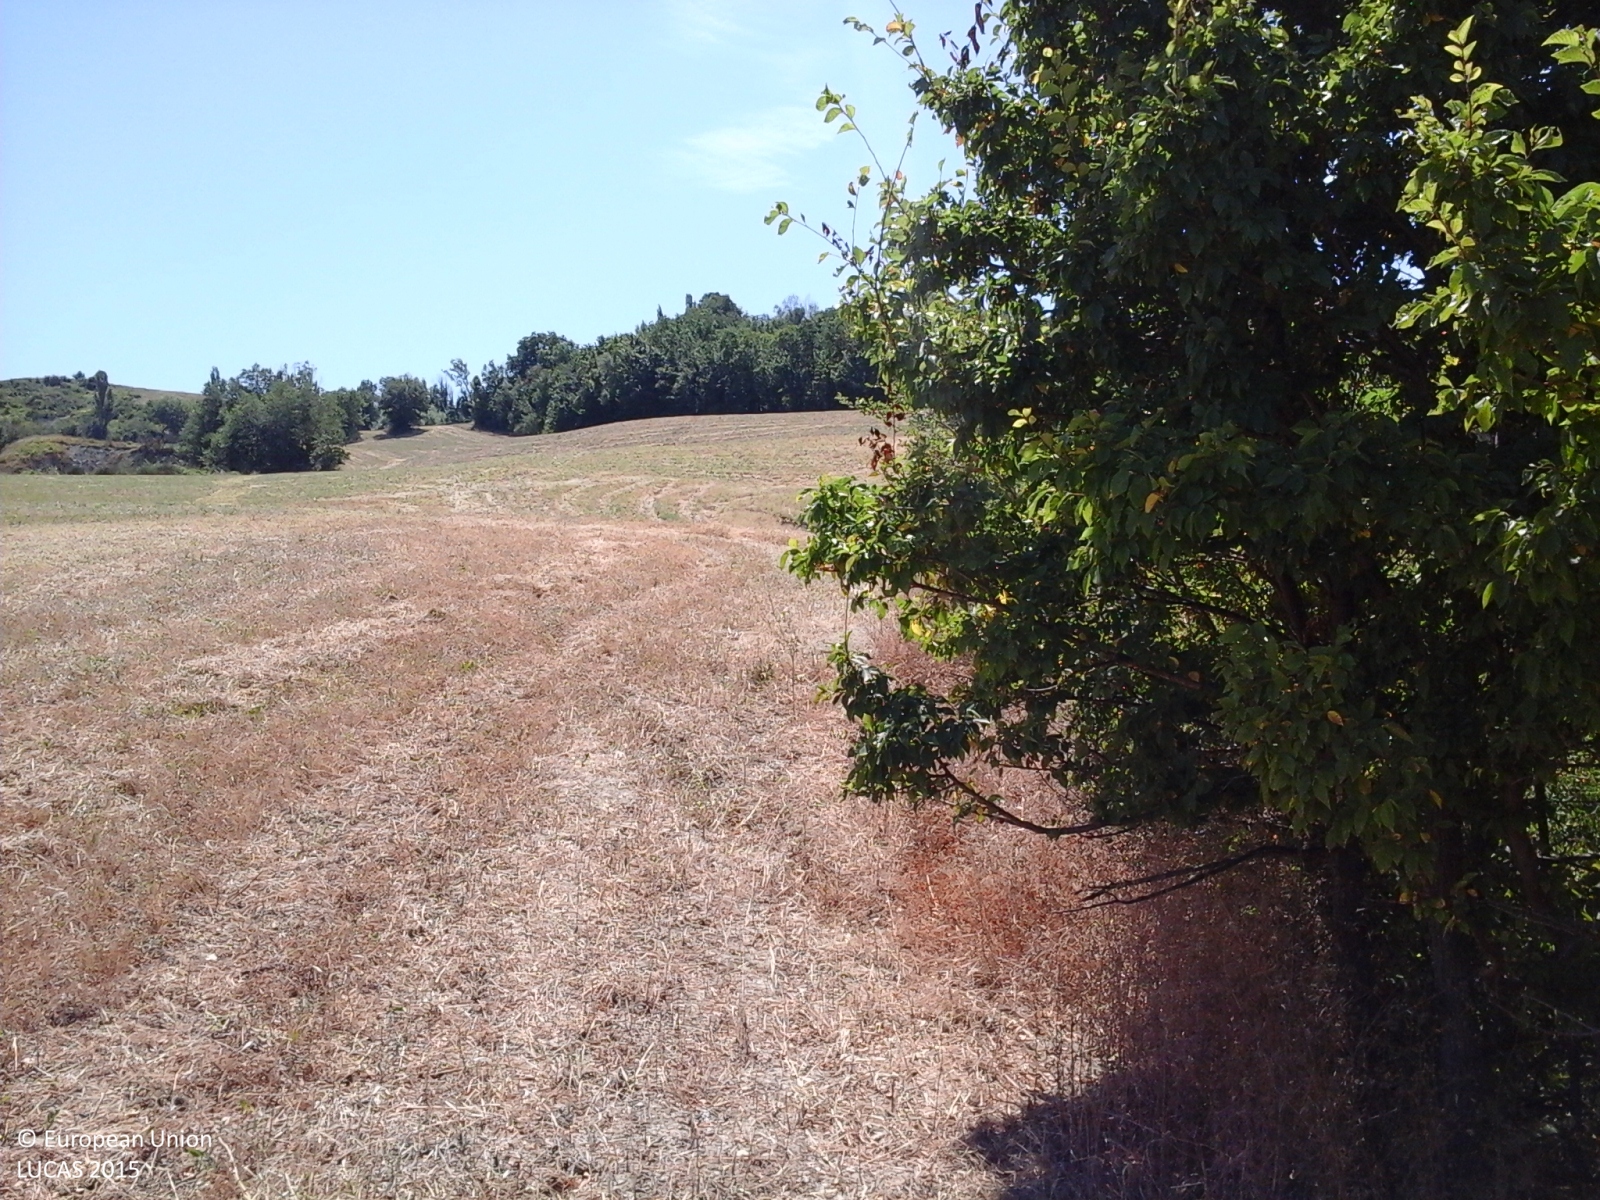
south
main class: Woodland
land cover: Broadleaved woodland
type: thermophilous deciduous forest
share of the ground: > 75 %
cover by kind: broadleaved forest trees 100 %
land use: Forestry
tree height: > 5 m
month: July
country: IT
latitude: 43.8303
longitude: 12.6176
